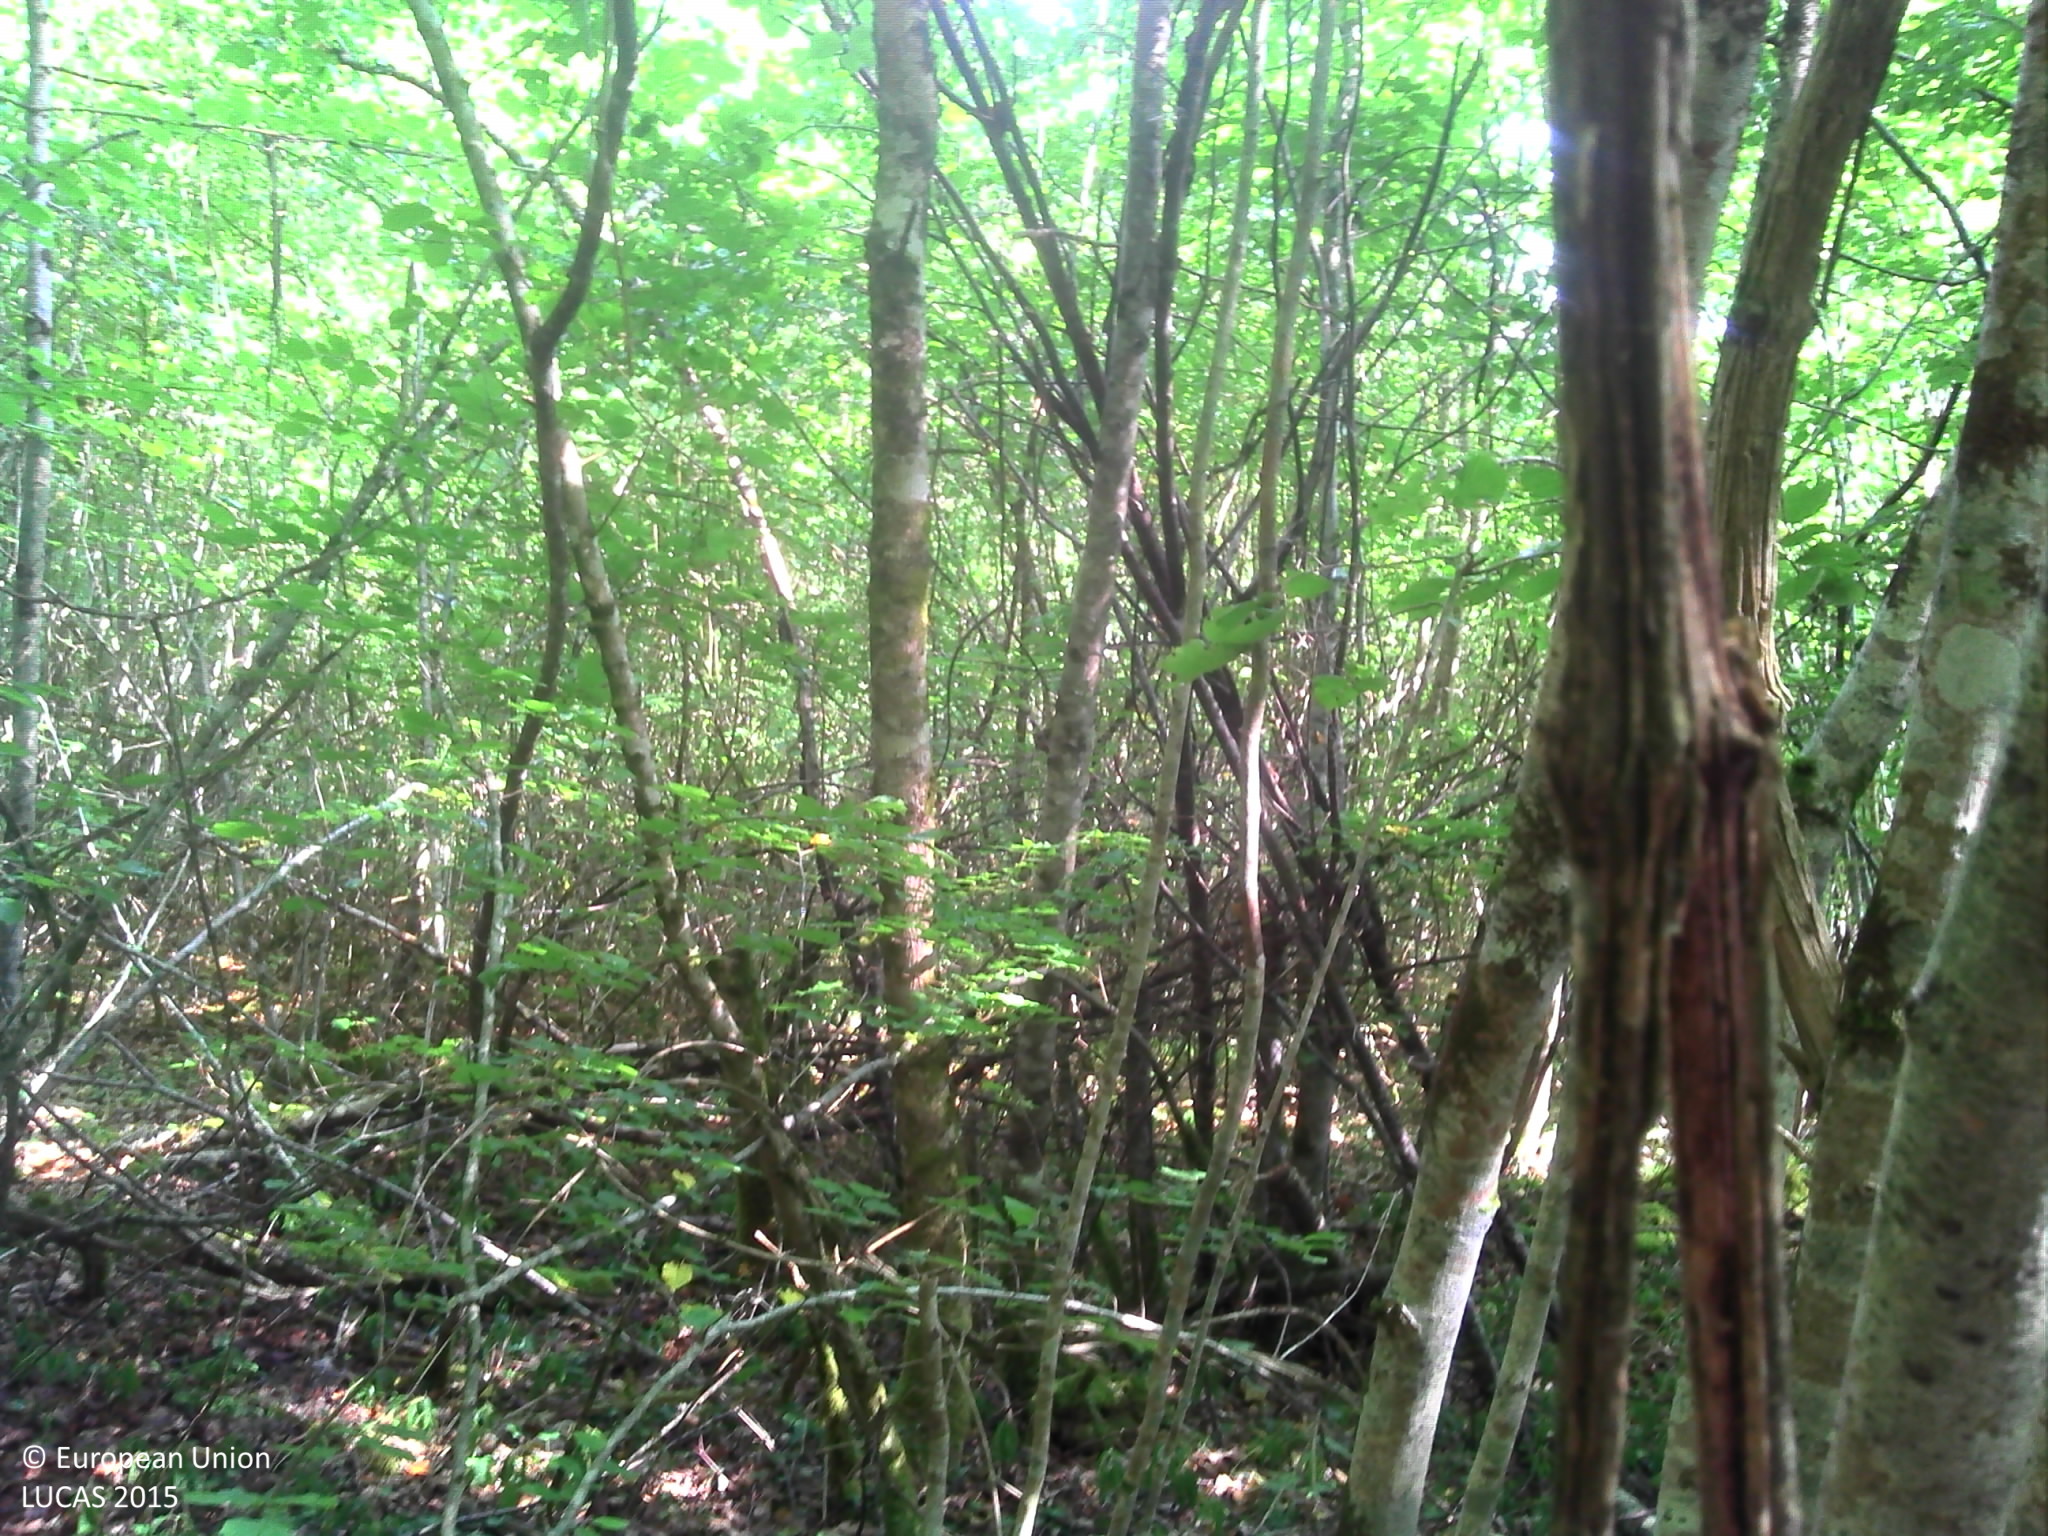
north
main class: Woodland
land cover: Broadleaved woodland
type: beech forest
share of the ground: > 75 %
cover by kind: broadleaved forest trees 85 %, coniferous forest trees 5 %, herbaceous plants 5 %, lichens and mosses 5 %
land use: Forestry
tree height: > 5 m
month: July
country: FR
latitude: 47.9958
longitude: 4.8661
